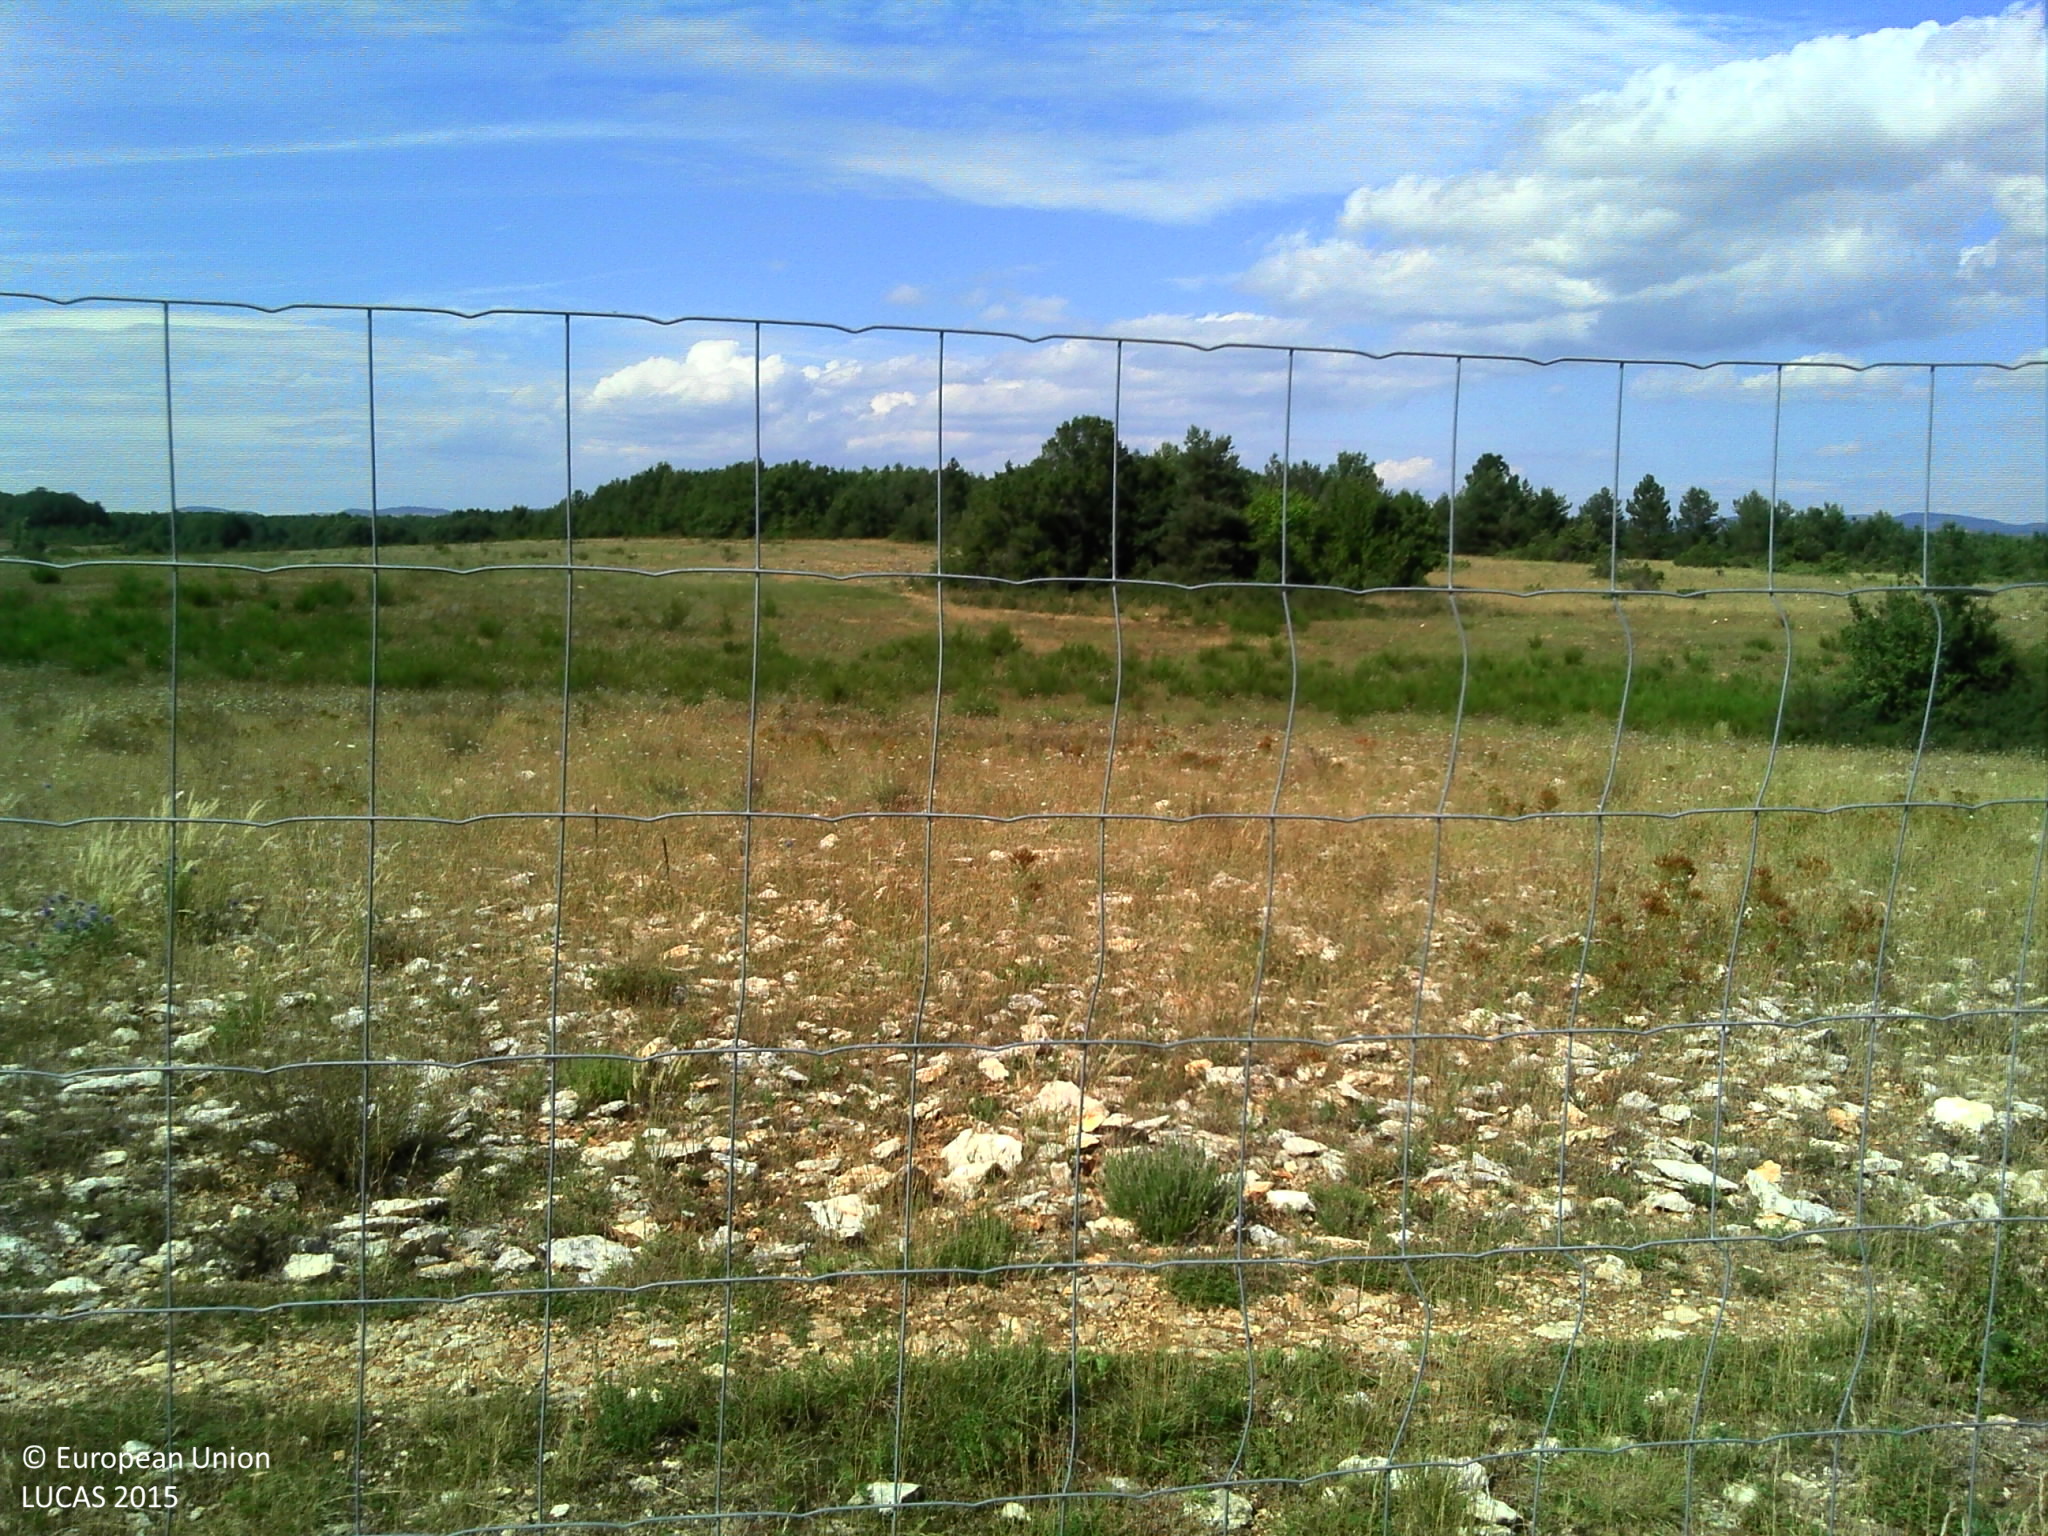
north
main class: Grassland
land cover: Spontaneously vegetated surfaces
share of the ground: > 75 %
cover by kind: herbaceous plants 70 %, unconsolidated bare surface 25 %, shrubs 5 %
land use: Semi-natural and natural areas not in use
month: July
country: FR
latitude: 44.0194
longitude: 5.5297
